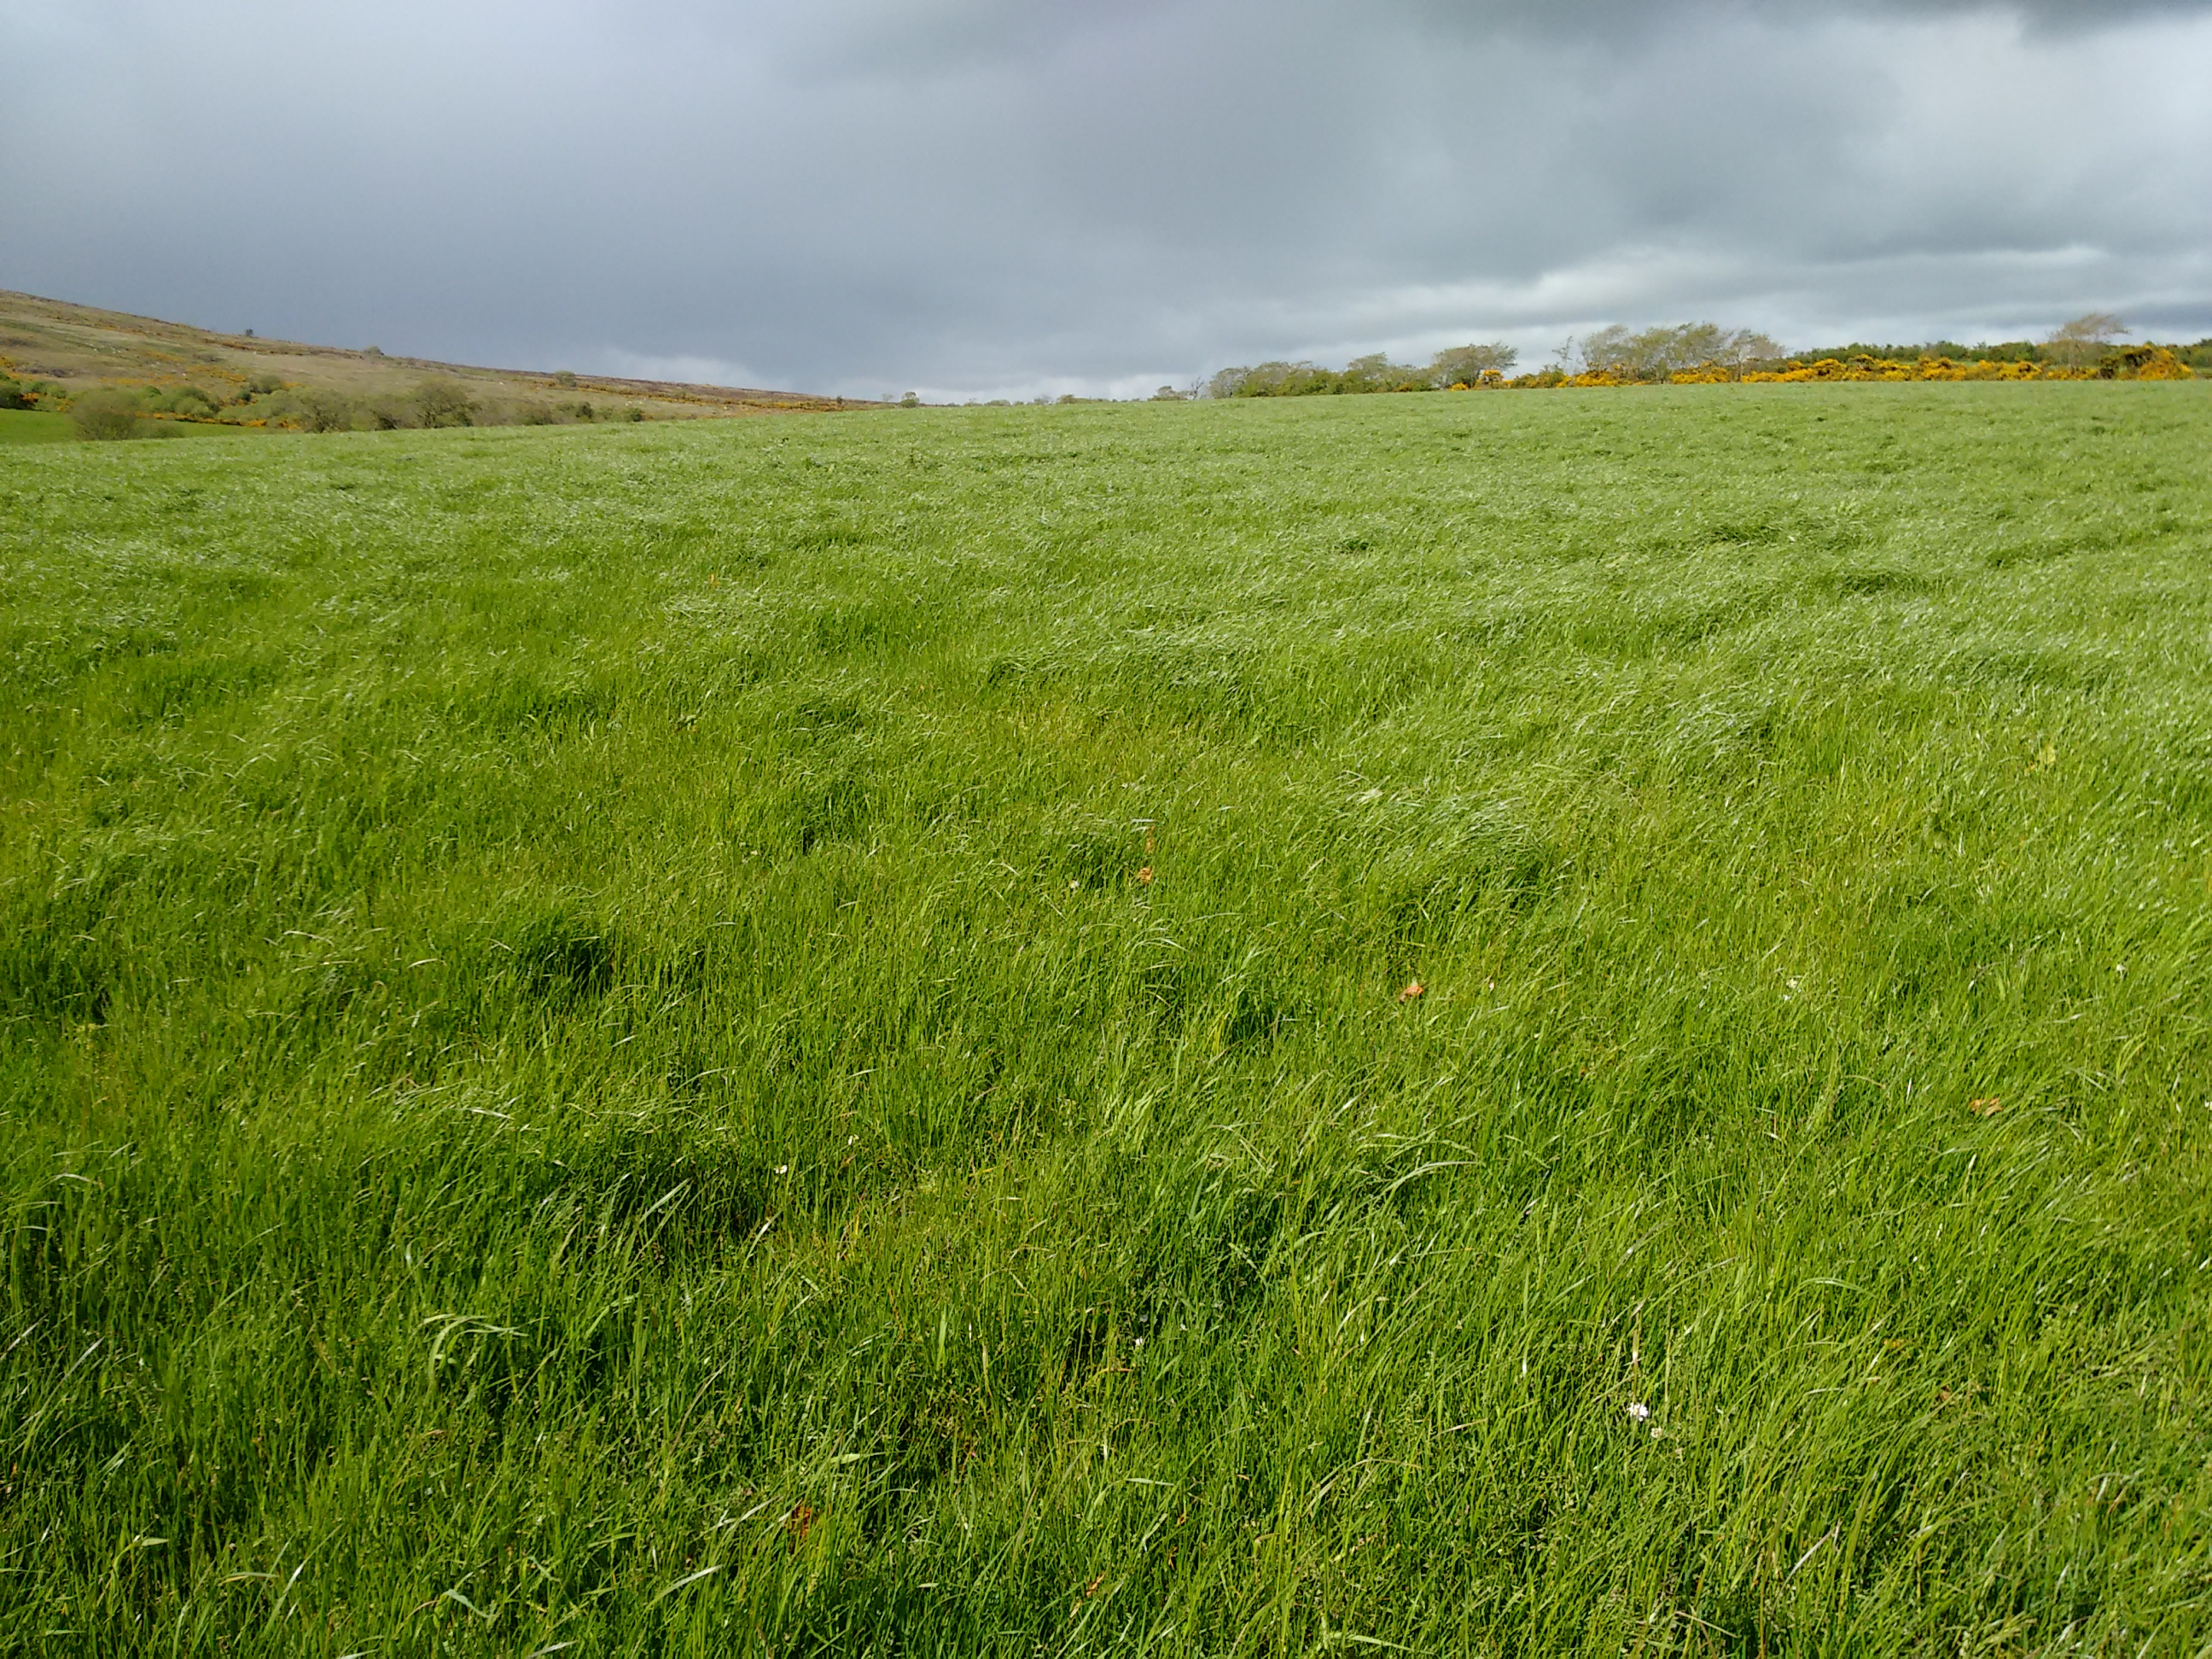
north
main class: Grassland
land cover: Grassland without tree/shrub cover
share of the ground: > 75 %
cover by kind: herbaceous plants 100 %
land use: Agriculture (excluding fallow land and kitchen gardens)
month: May
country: GB
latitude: 54.9166
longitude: -7.2281
